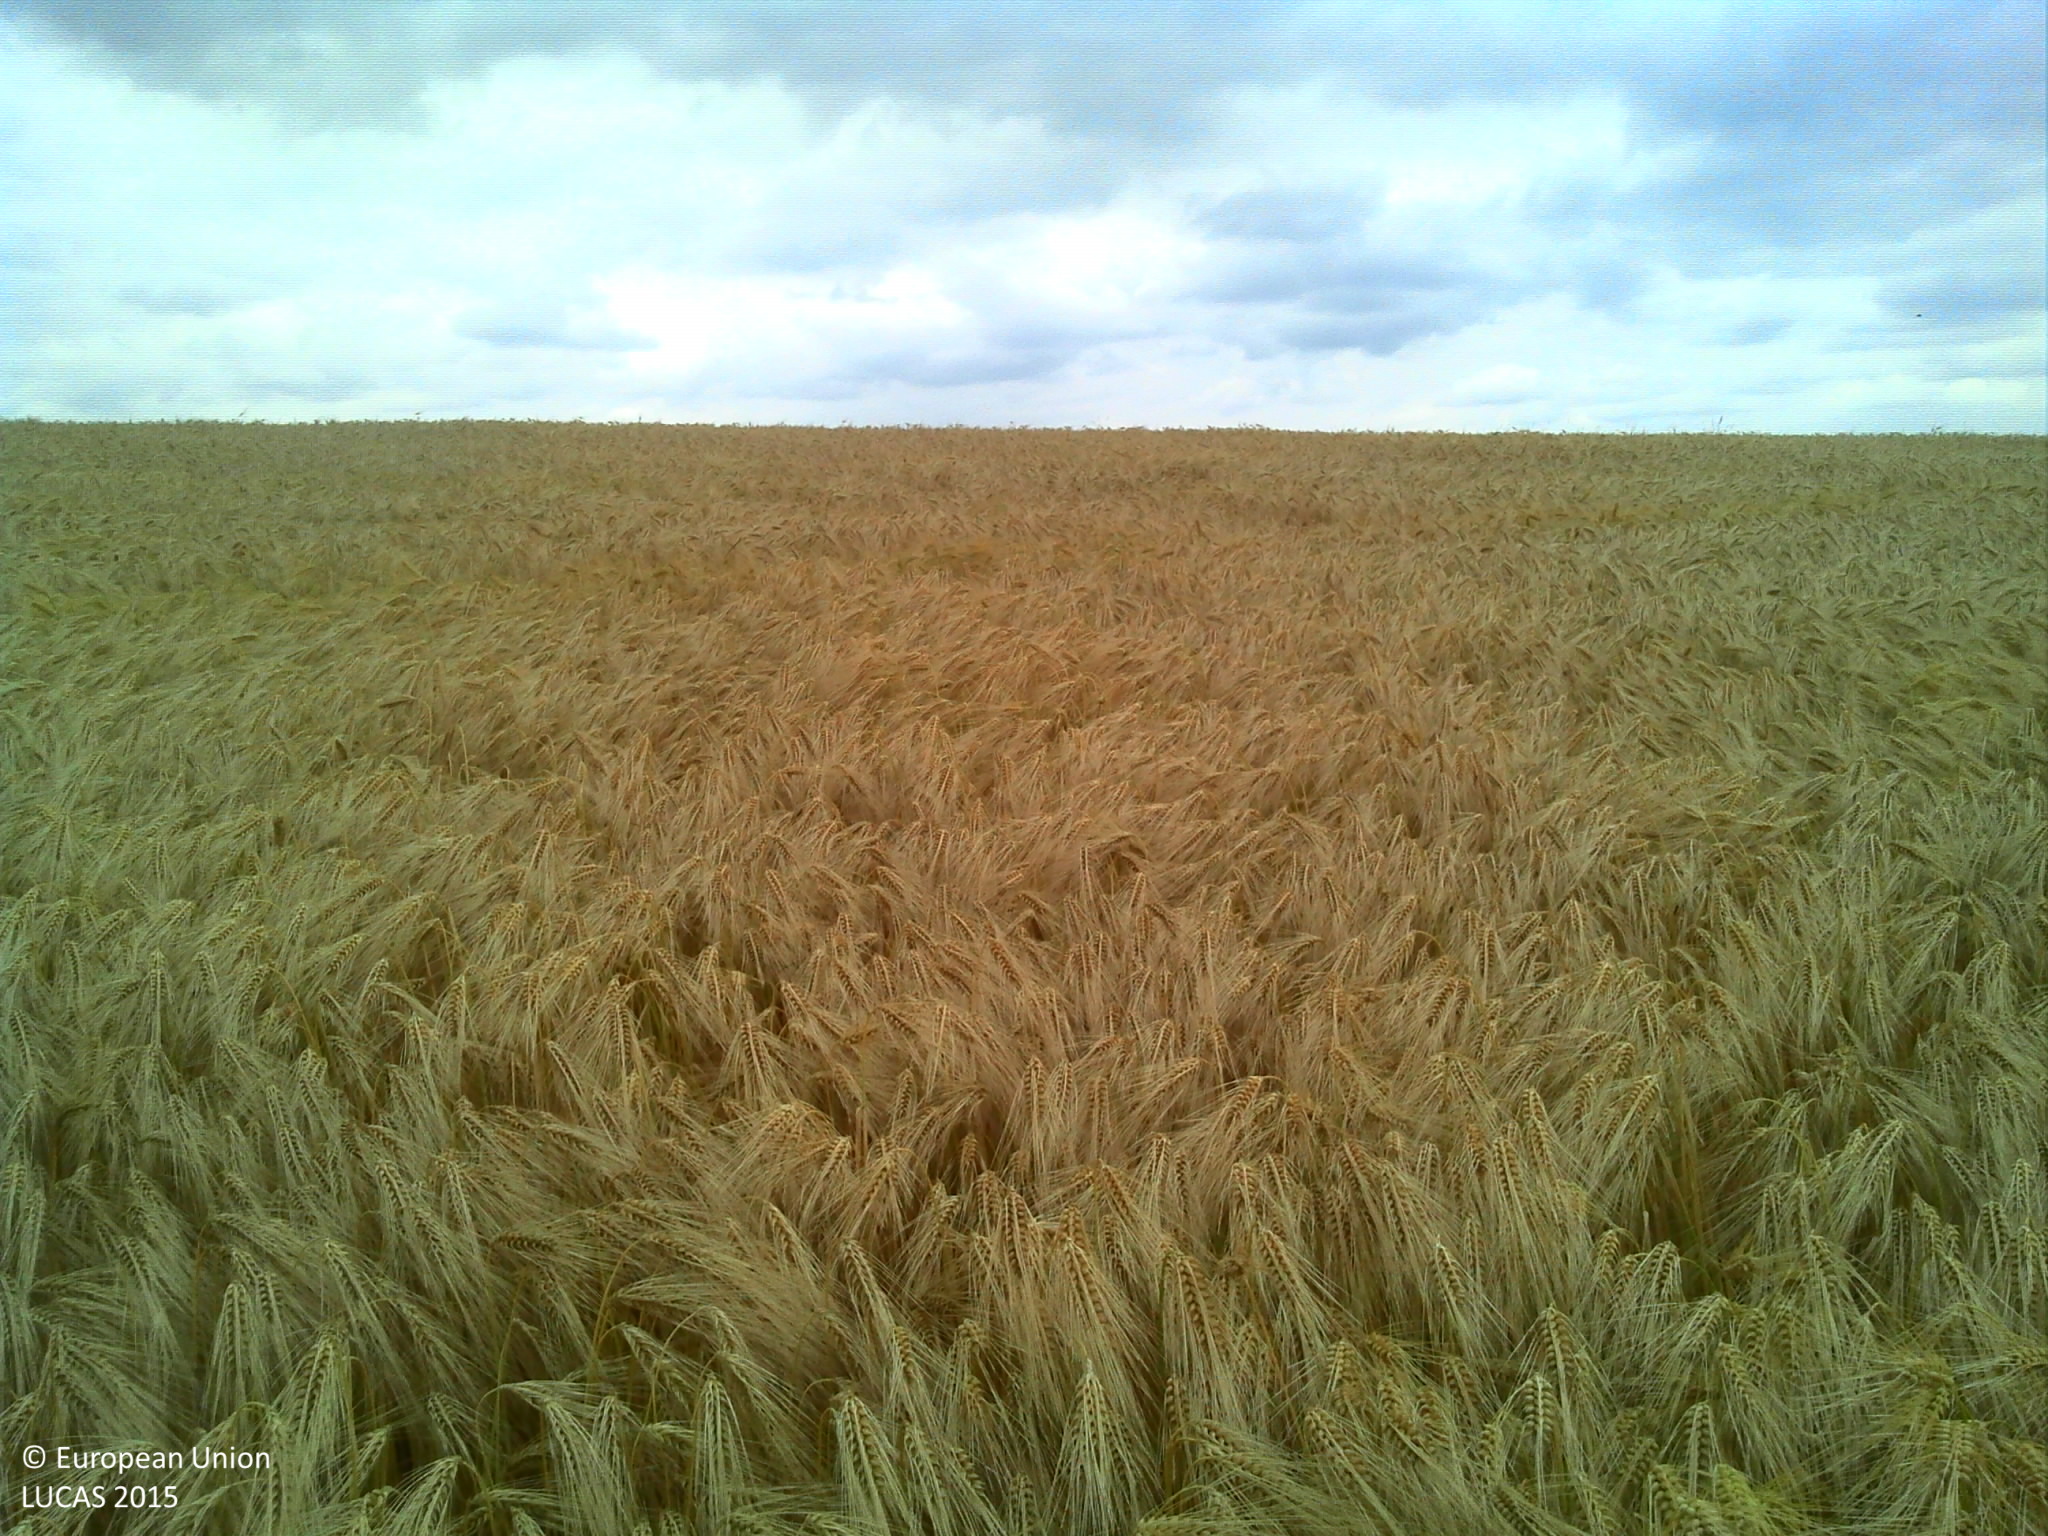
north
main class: Cropland
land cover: Barley
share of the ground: > 75 %
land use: Agriculture (excluding fallow land and kitchen gardens)
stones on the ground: < 10 %
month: June
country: FR
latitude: 49.4323
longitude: 3.6921
